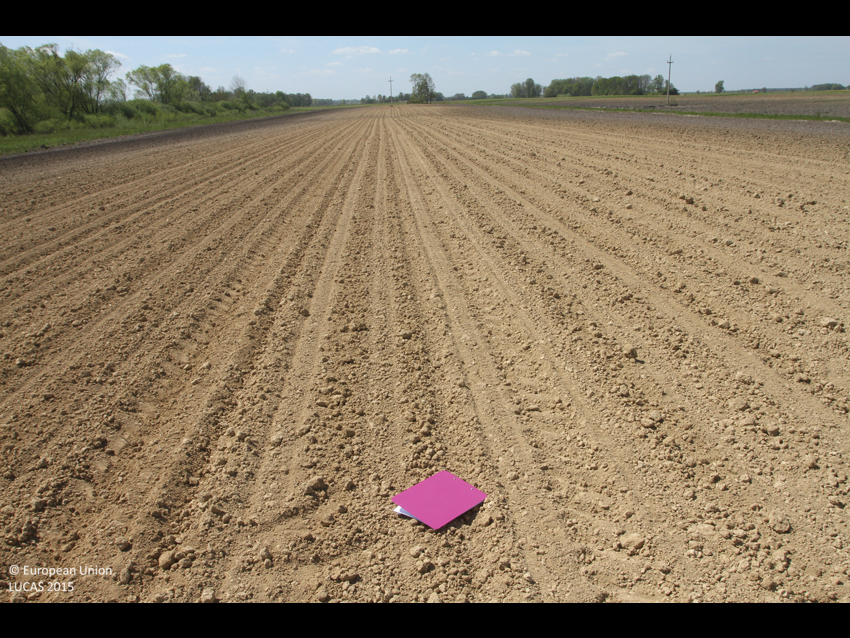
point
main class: Cropland
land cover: Soya
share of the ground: < 10 %
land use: Agriculture (excluding fallow land and kitchen gardens)
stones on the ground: < 10 %
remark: Tilled/Sowed
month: April
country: HR
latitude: 44.8738
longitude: 18.9045
